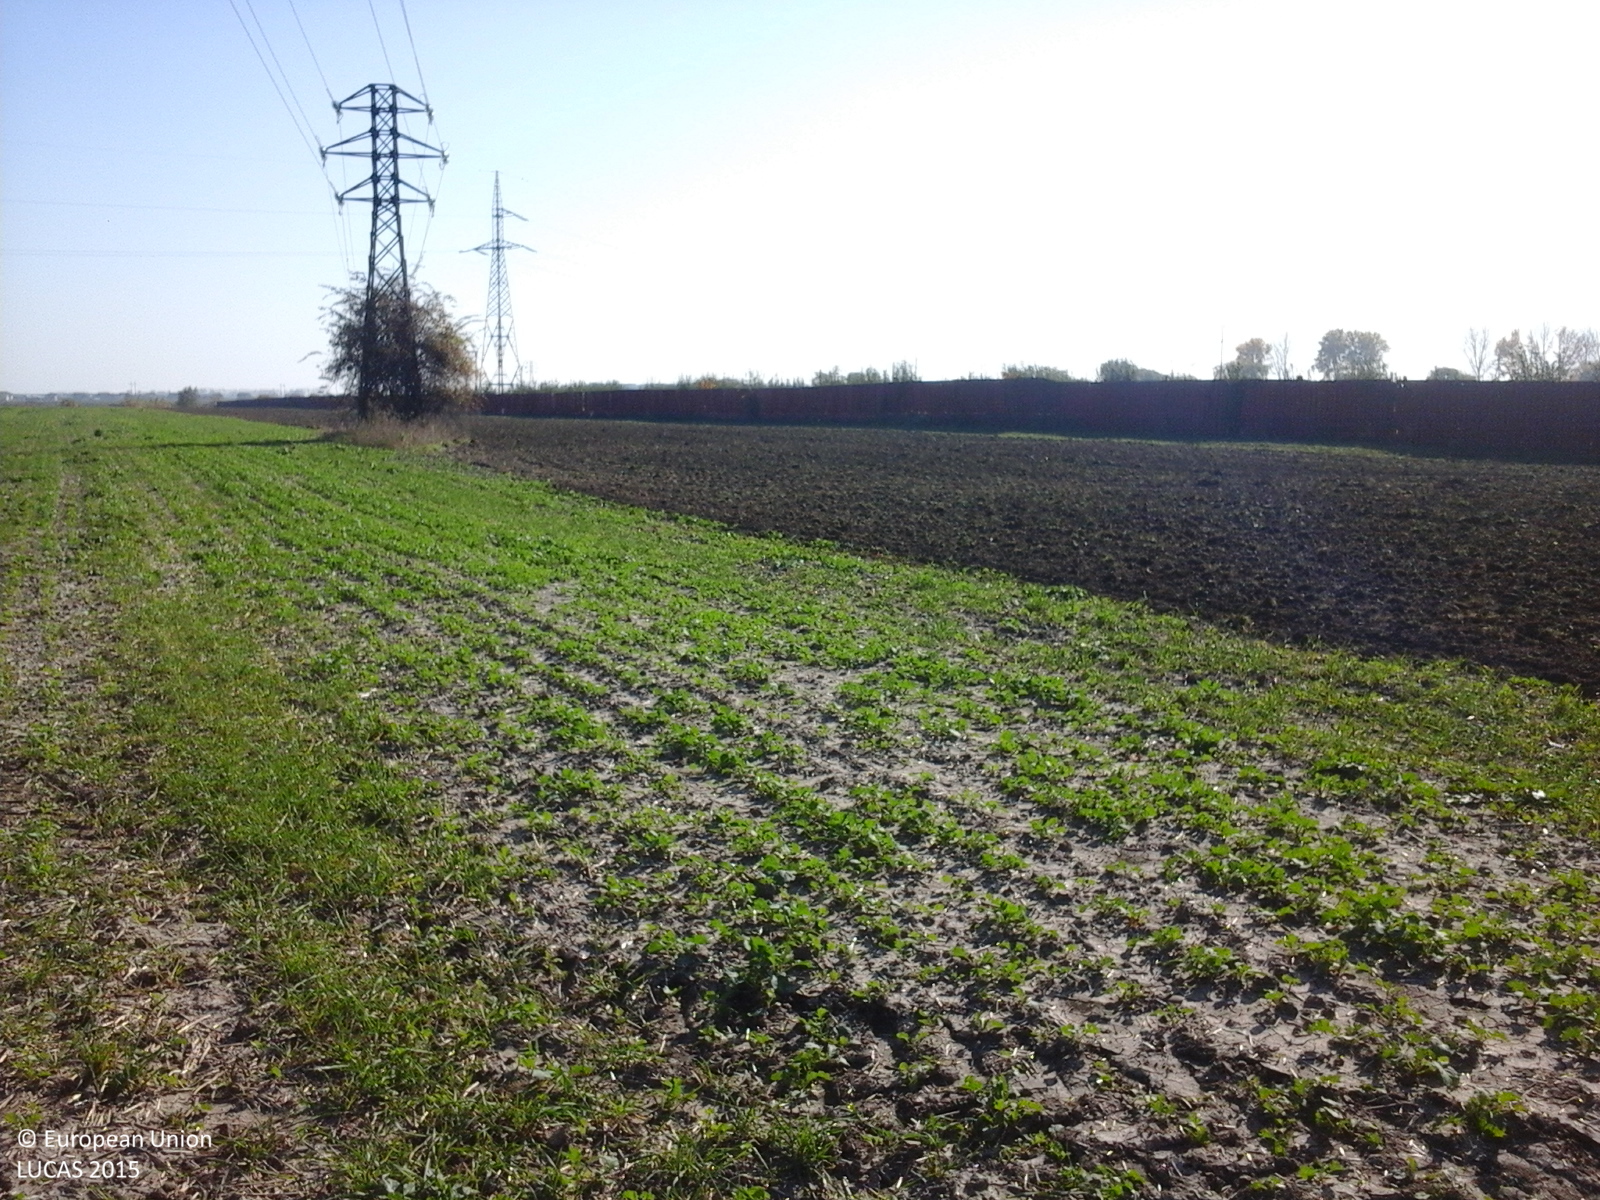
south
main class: Cropland
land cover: Rape and turnip rape
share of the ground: 50 - 75 %
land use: Agriculture (excluding fallow land and kitchen gardens)
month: October
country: RO
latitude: 45.6739
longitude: 27.1280
